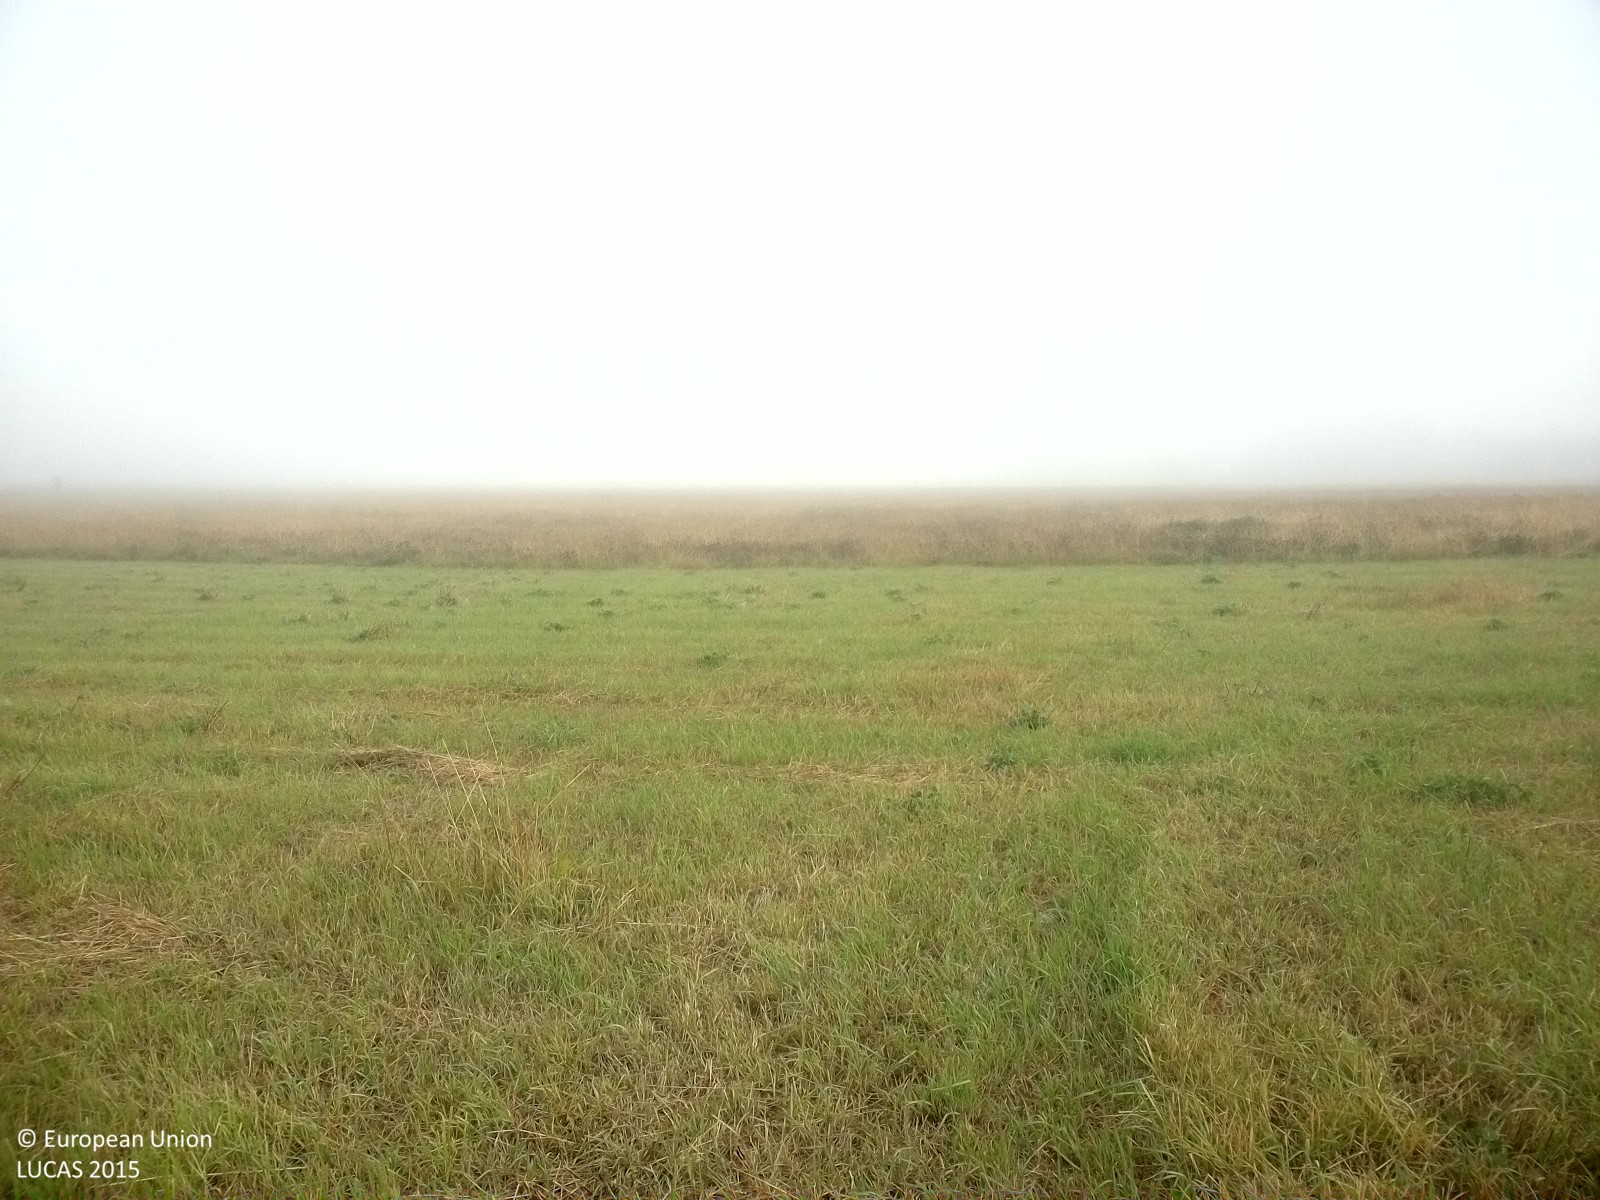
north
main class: Grassland
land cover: Grassland without tree/shrub cover
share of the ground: > 75 %
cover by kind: herbaceous plants 100 %
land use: Agriculture (excluding fallow land and kitchen gardens)
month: August
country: SE
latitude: 59.3447
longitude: 15.2137
